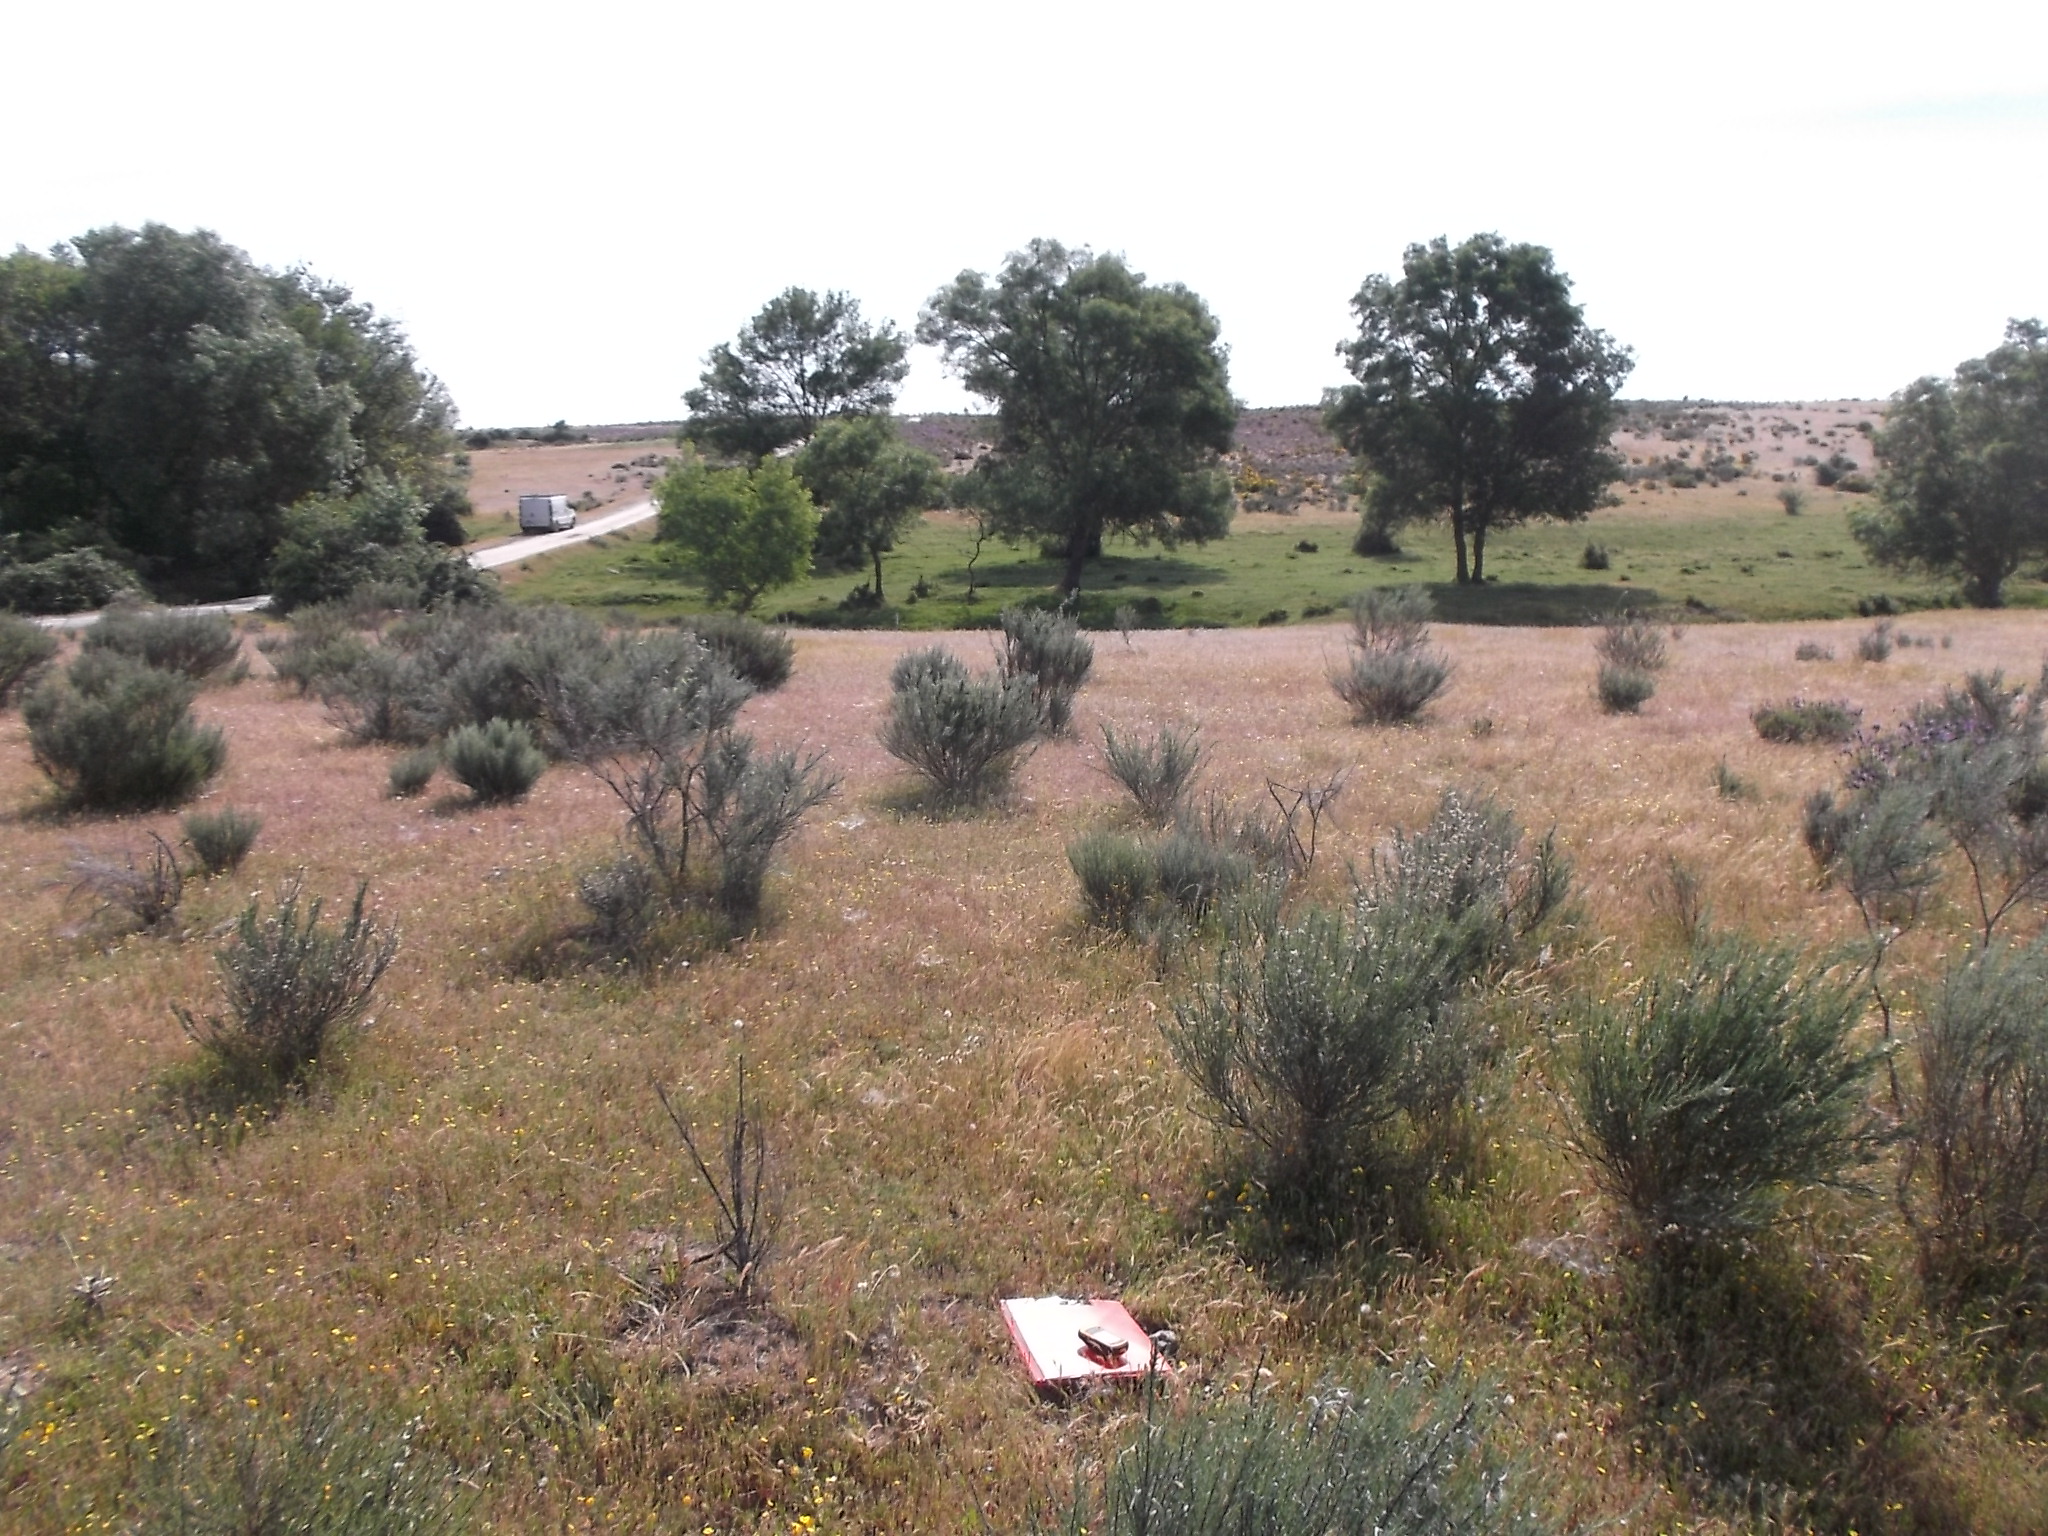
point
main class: Shrubland
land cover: Shrubland without tree cover
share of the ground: 50 - 75 %
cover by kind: shrubs 70 %, herbaceous plants 30 %
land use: Semi-natural and natural areas not in use
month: May
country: ES
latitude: 41.0130
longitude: -6.3955
